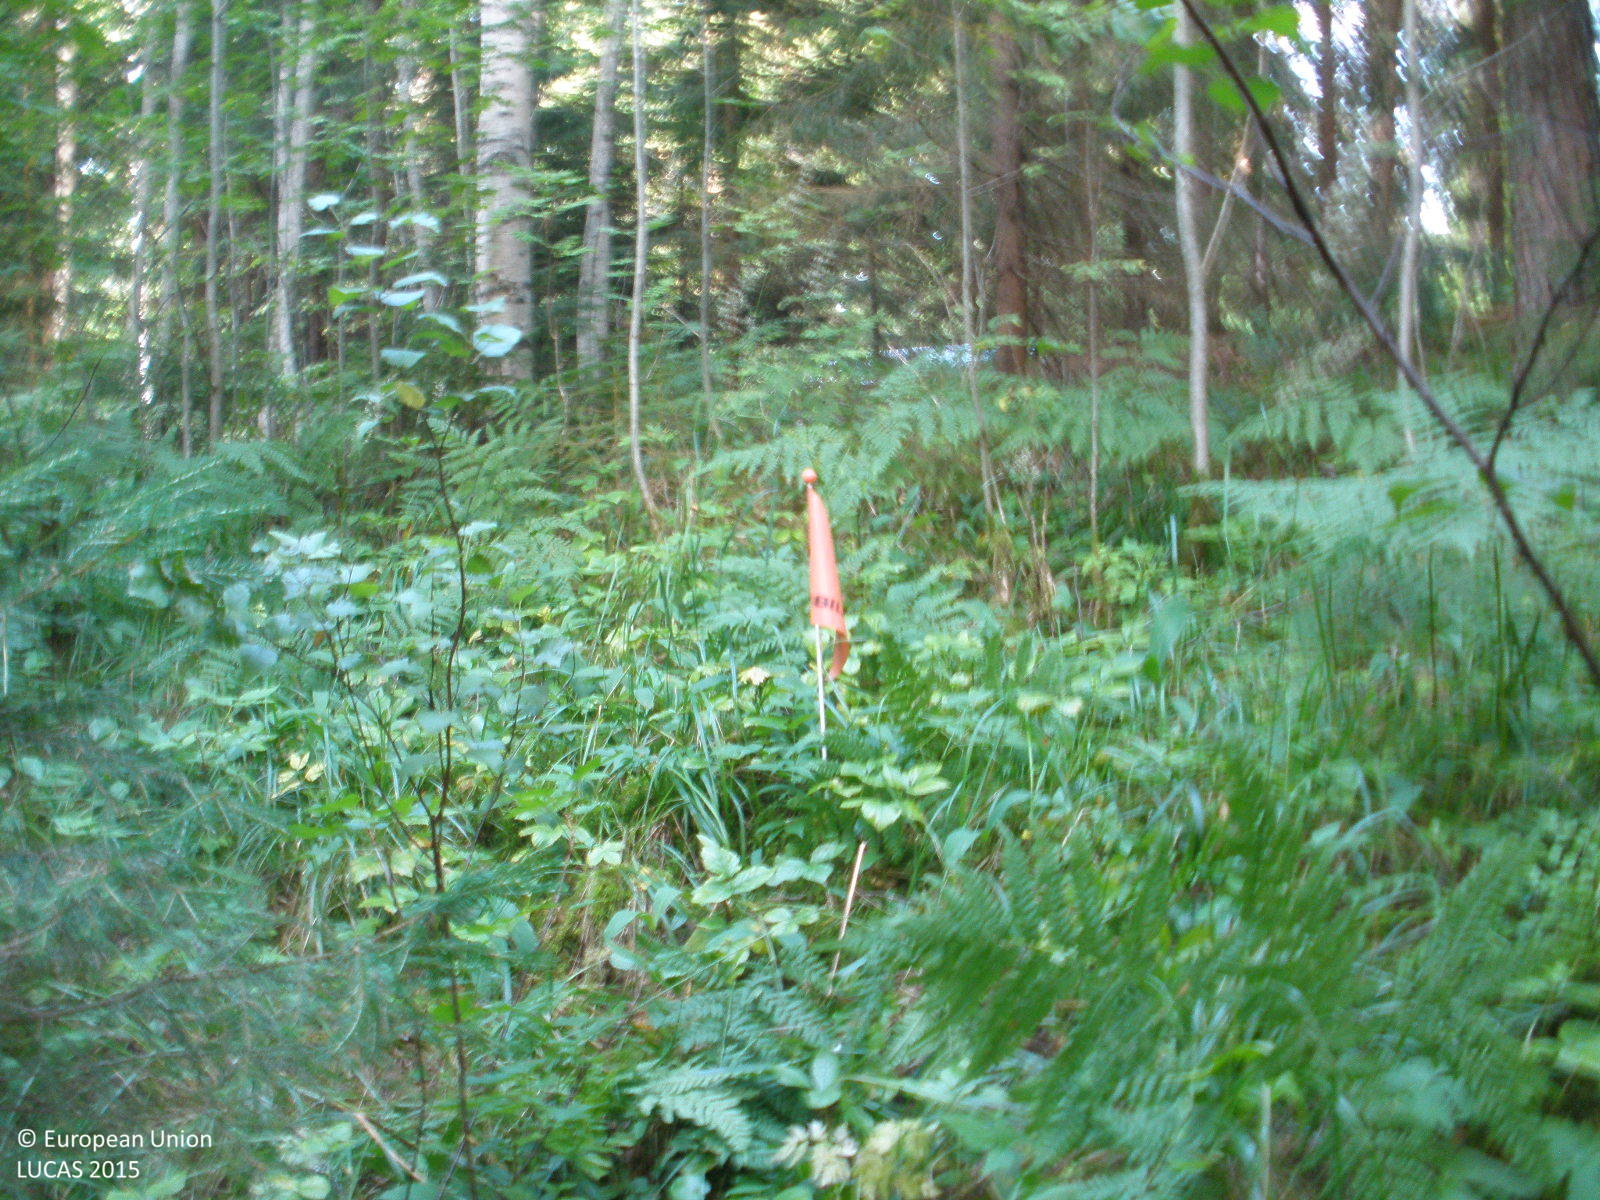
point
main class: Woodland
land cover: Spruce dominated mixed woodland
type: boreal forest
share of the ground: > 75 %
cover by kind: coniferous forest trees 65 %, broadleaved forest trees 25 %, herbaceous plants 10 %
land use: Forestry
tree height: > 5 m
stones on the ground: < 10 %
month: August
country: FI
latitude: 60.9740
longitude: 24.7974
